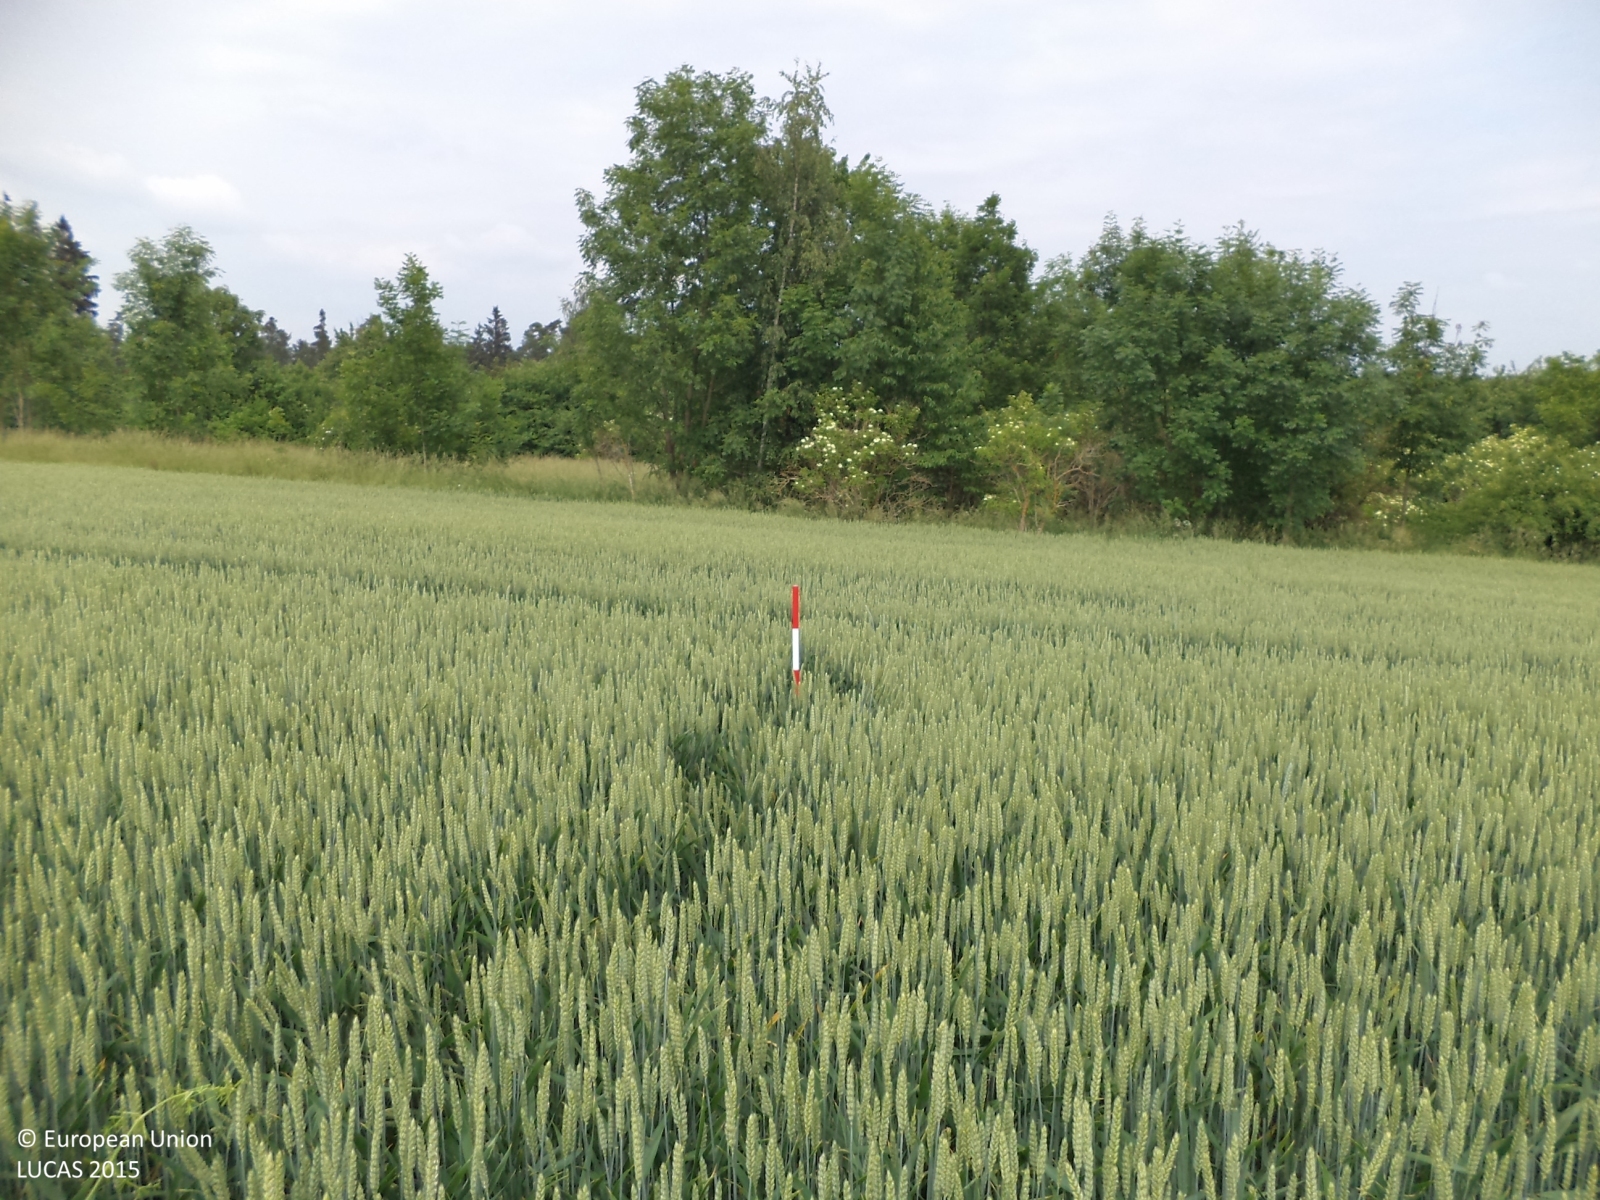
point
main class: Cropland
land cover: Common wheat
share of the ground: > 75 %
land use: Agriculture (excluding fallow land and kitchen gardens)
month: June
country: CZ
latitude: 49.1806
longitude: 14.4048
